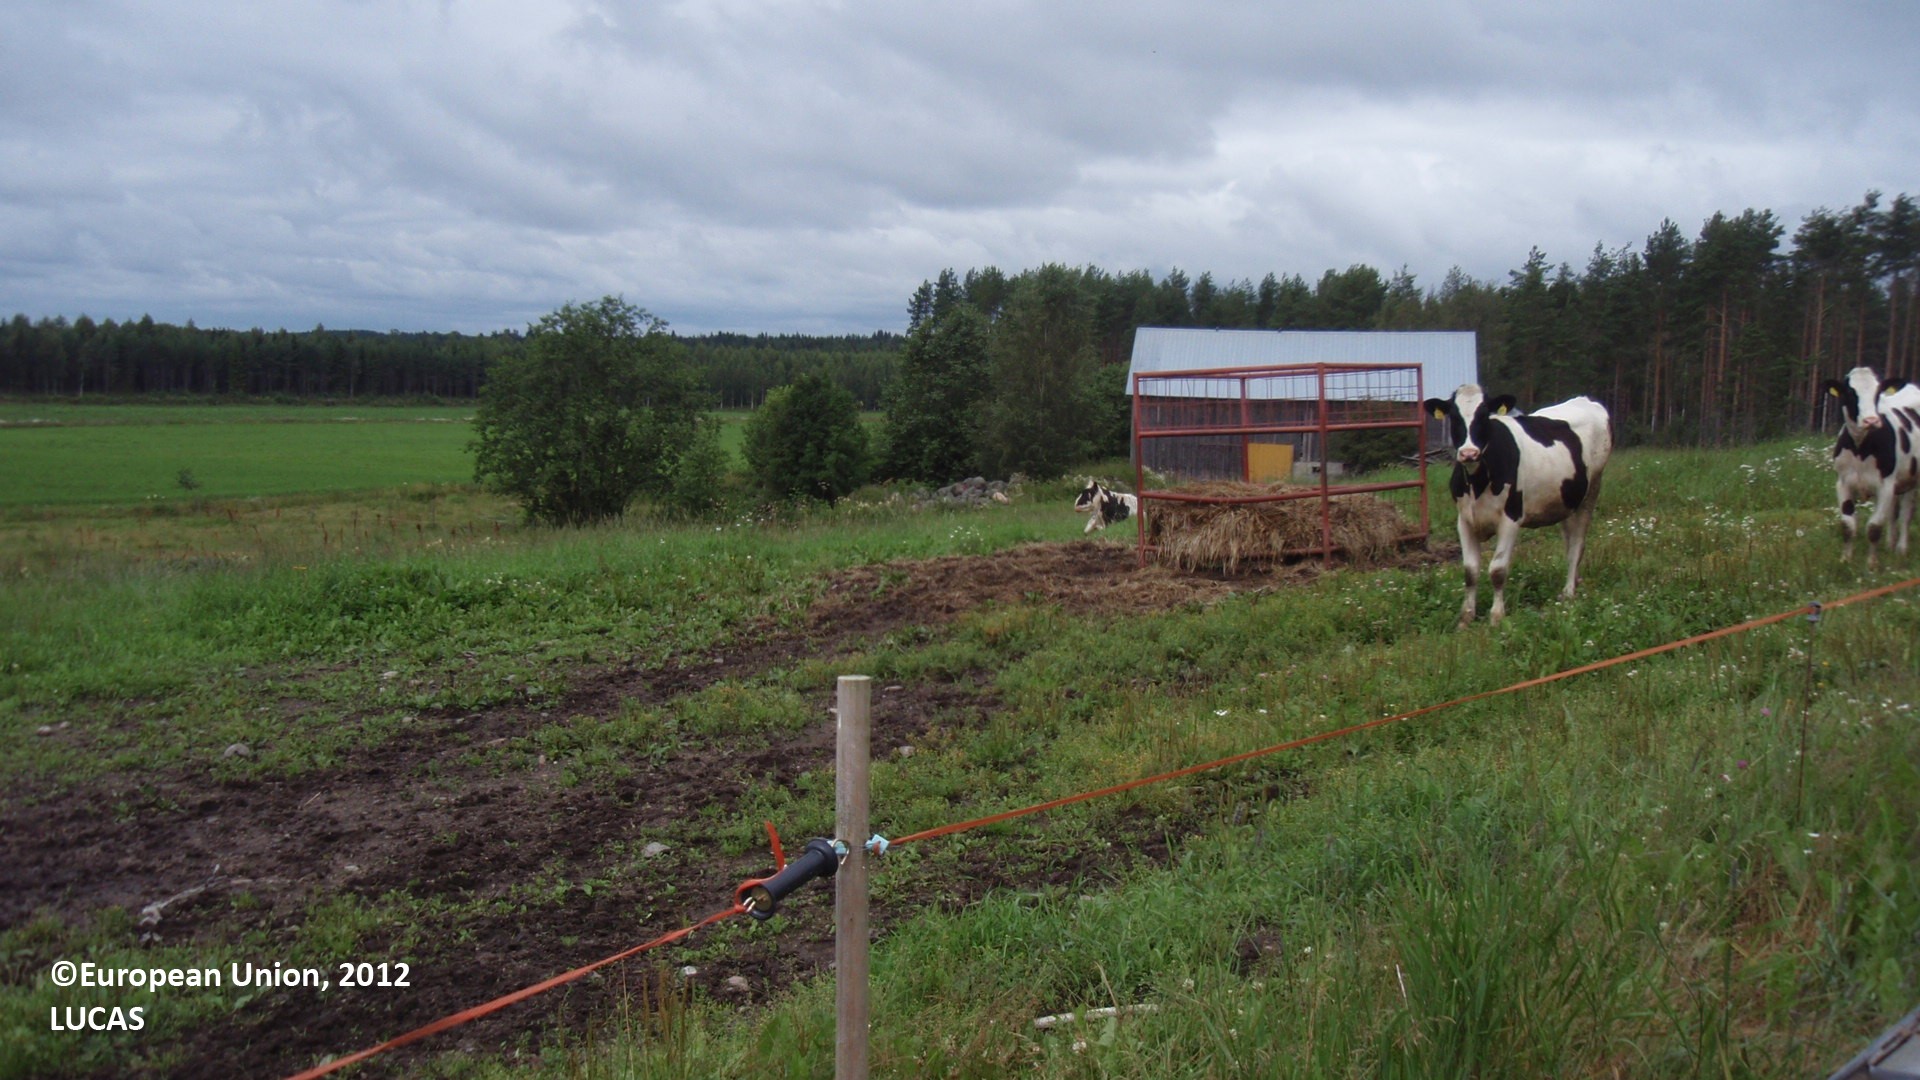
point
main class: Grassland
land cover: Grassland without tree/shrub cover
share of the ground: > 75 %
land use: Agriculture (excluding fallow land and kitchen gardens)
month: July
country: FI
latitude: 61.5329
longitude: 27.3815
